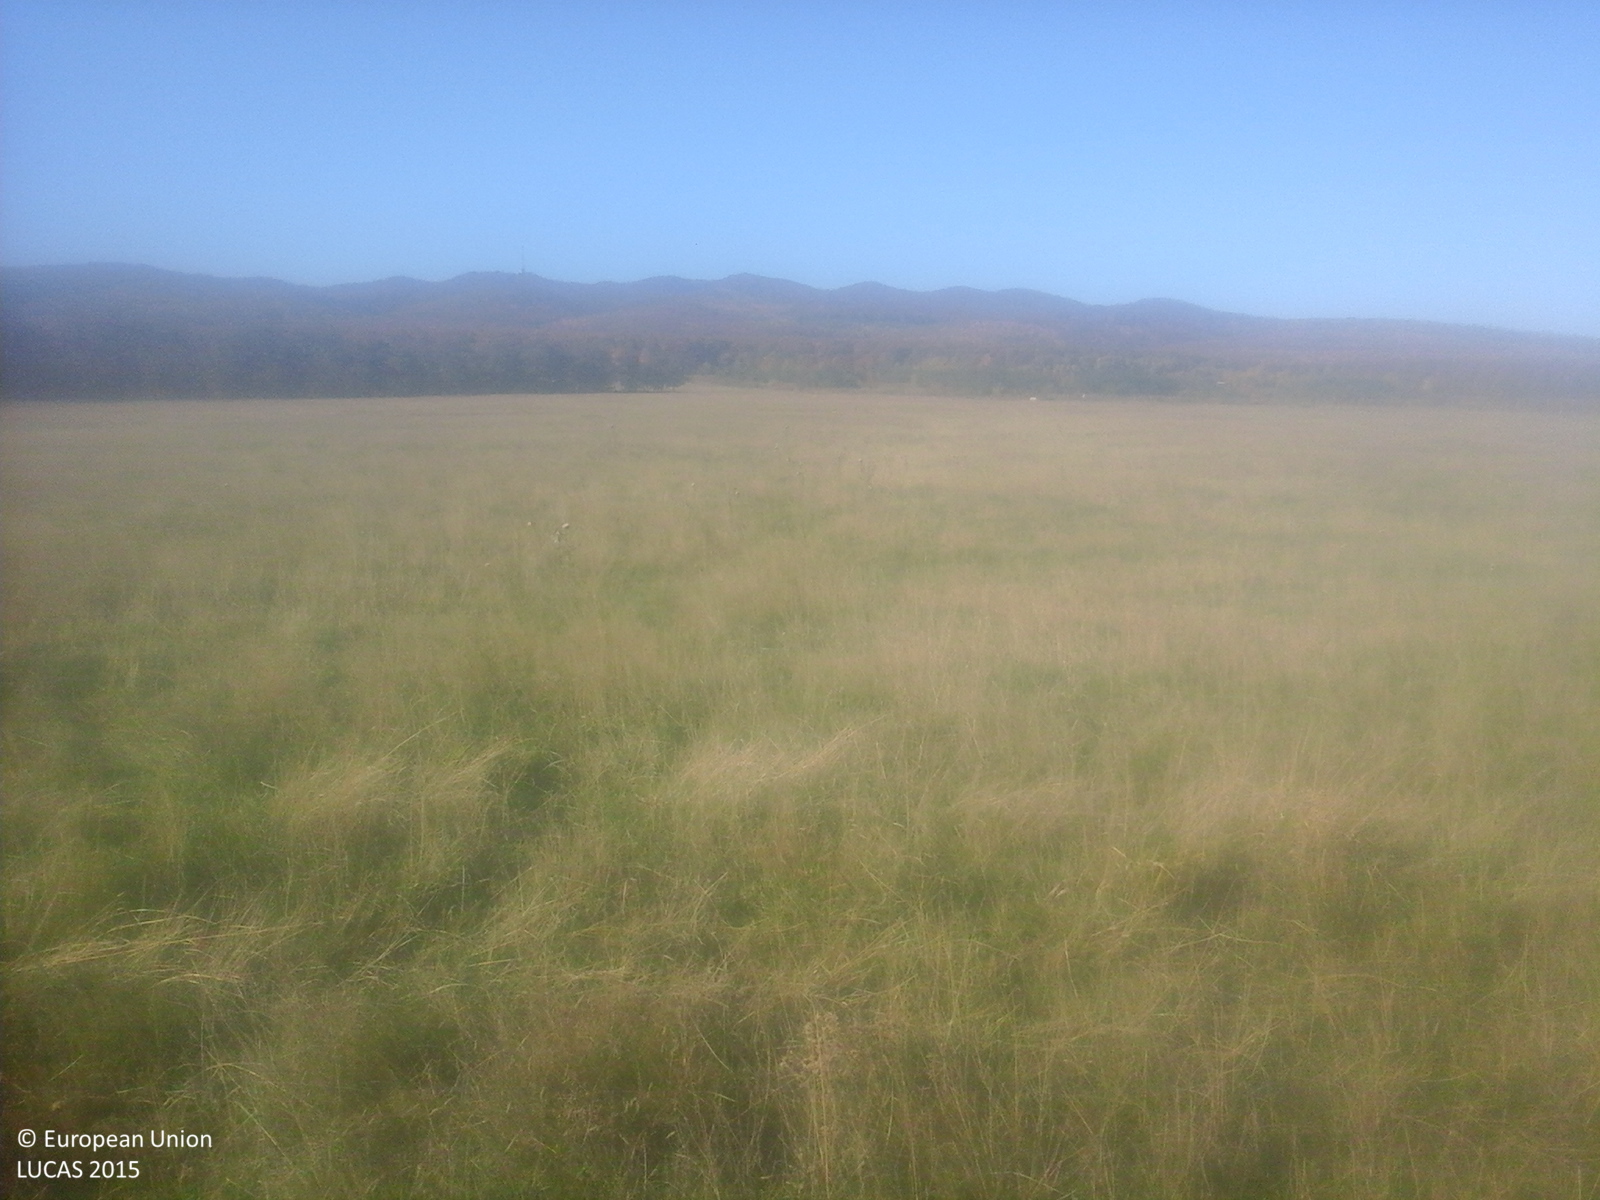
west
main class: Grassland
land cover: Grassland without tree/shrub cover
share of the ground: > 75 %
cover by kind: herbaceous plants 100 %
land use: Agriculture (excluding fallow land and kitchen gardens)
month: October
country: RO
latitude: 45.8774
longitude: 27.0080
